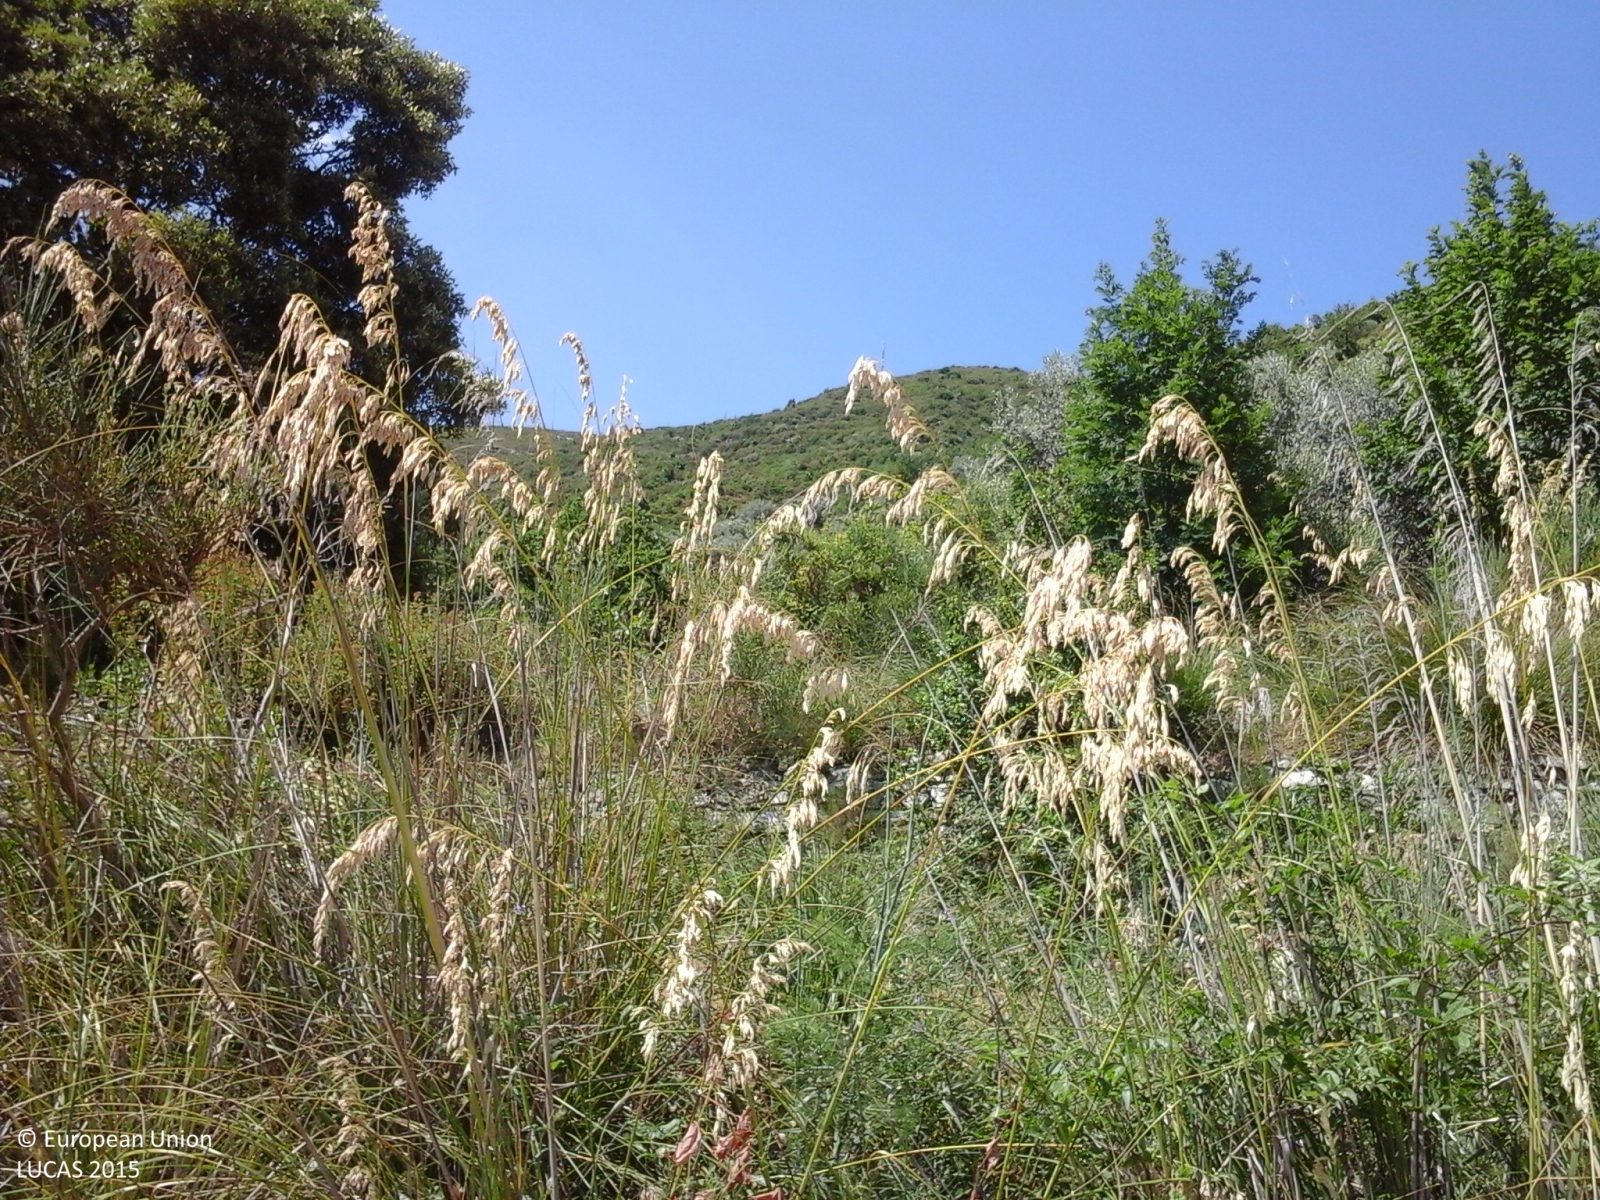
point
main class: Shrubland
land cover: Shrubland with sparse tree cover
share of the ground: > 75 %
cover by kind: shrubs 95 %, broadleaved forest trees 5 %
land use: Semi-natural and natural areas not in use
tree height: > 5 m
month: June
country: IT
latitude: 40.2475
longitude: 15.0208
